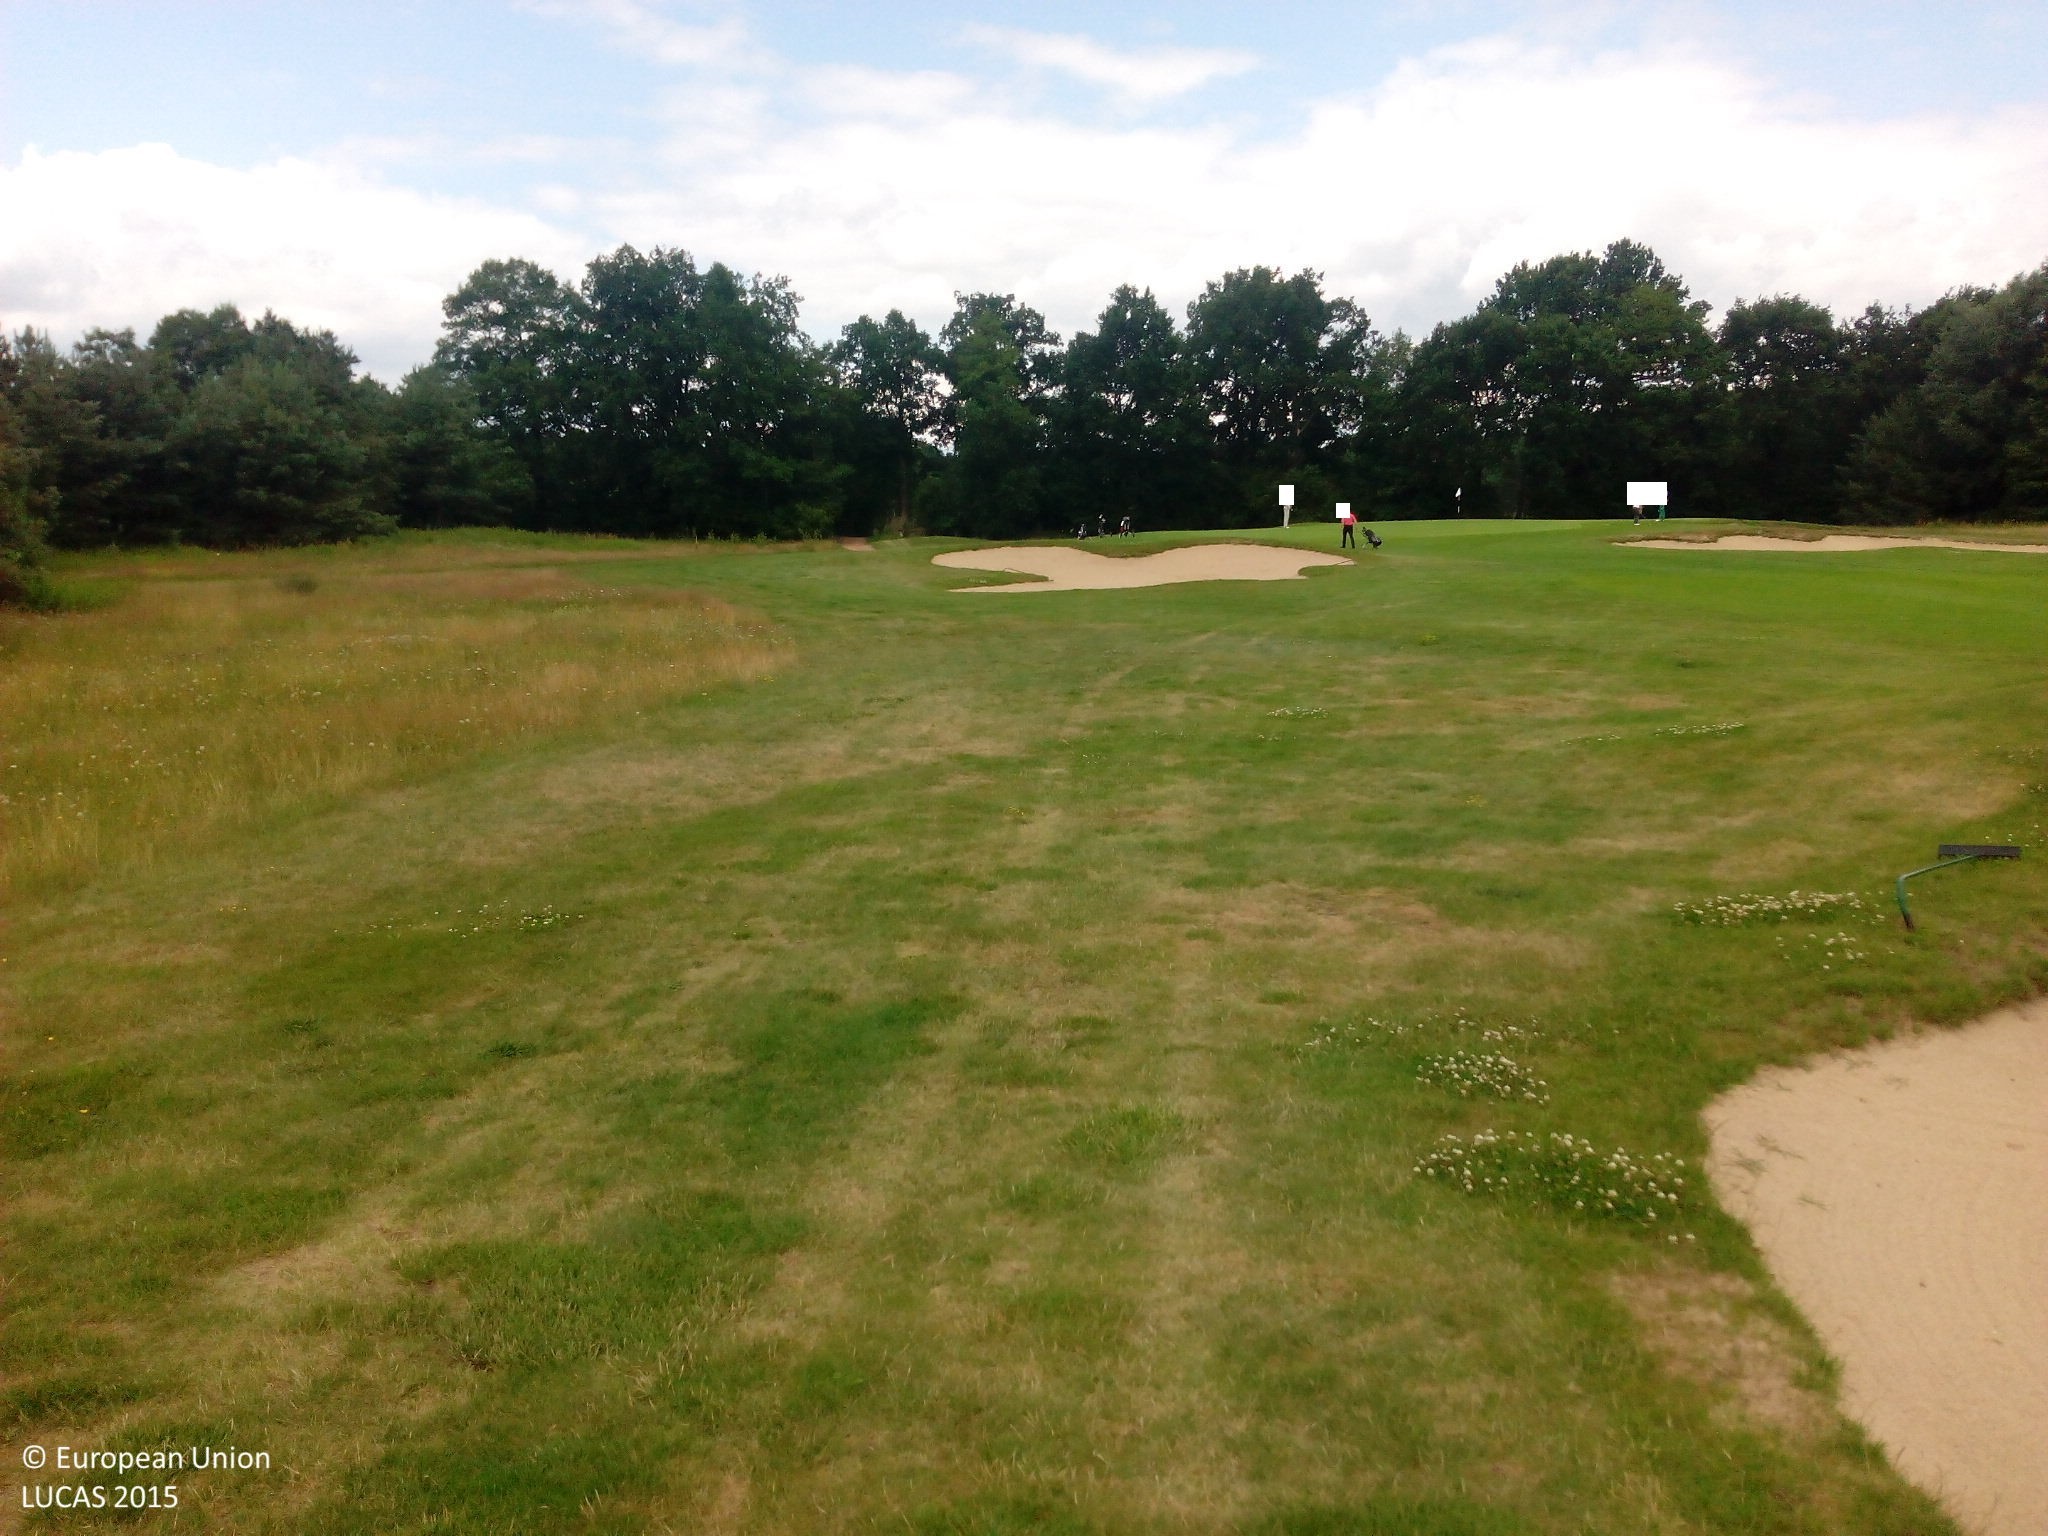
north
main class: Grassland
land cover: Grassland without tree/shrub cover
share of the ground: > 75 %
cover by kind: herbaceous plants 100 %
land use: Sport
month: July
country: DE
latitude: 52.6408
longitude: 12.4084
